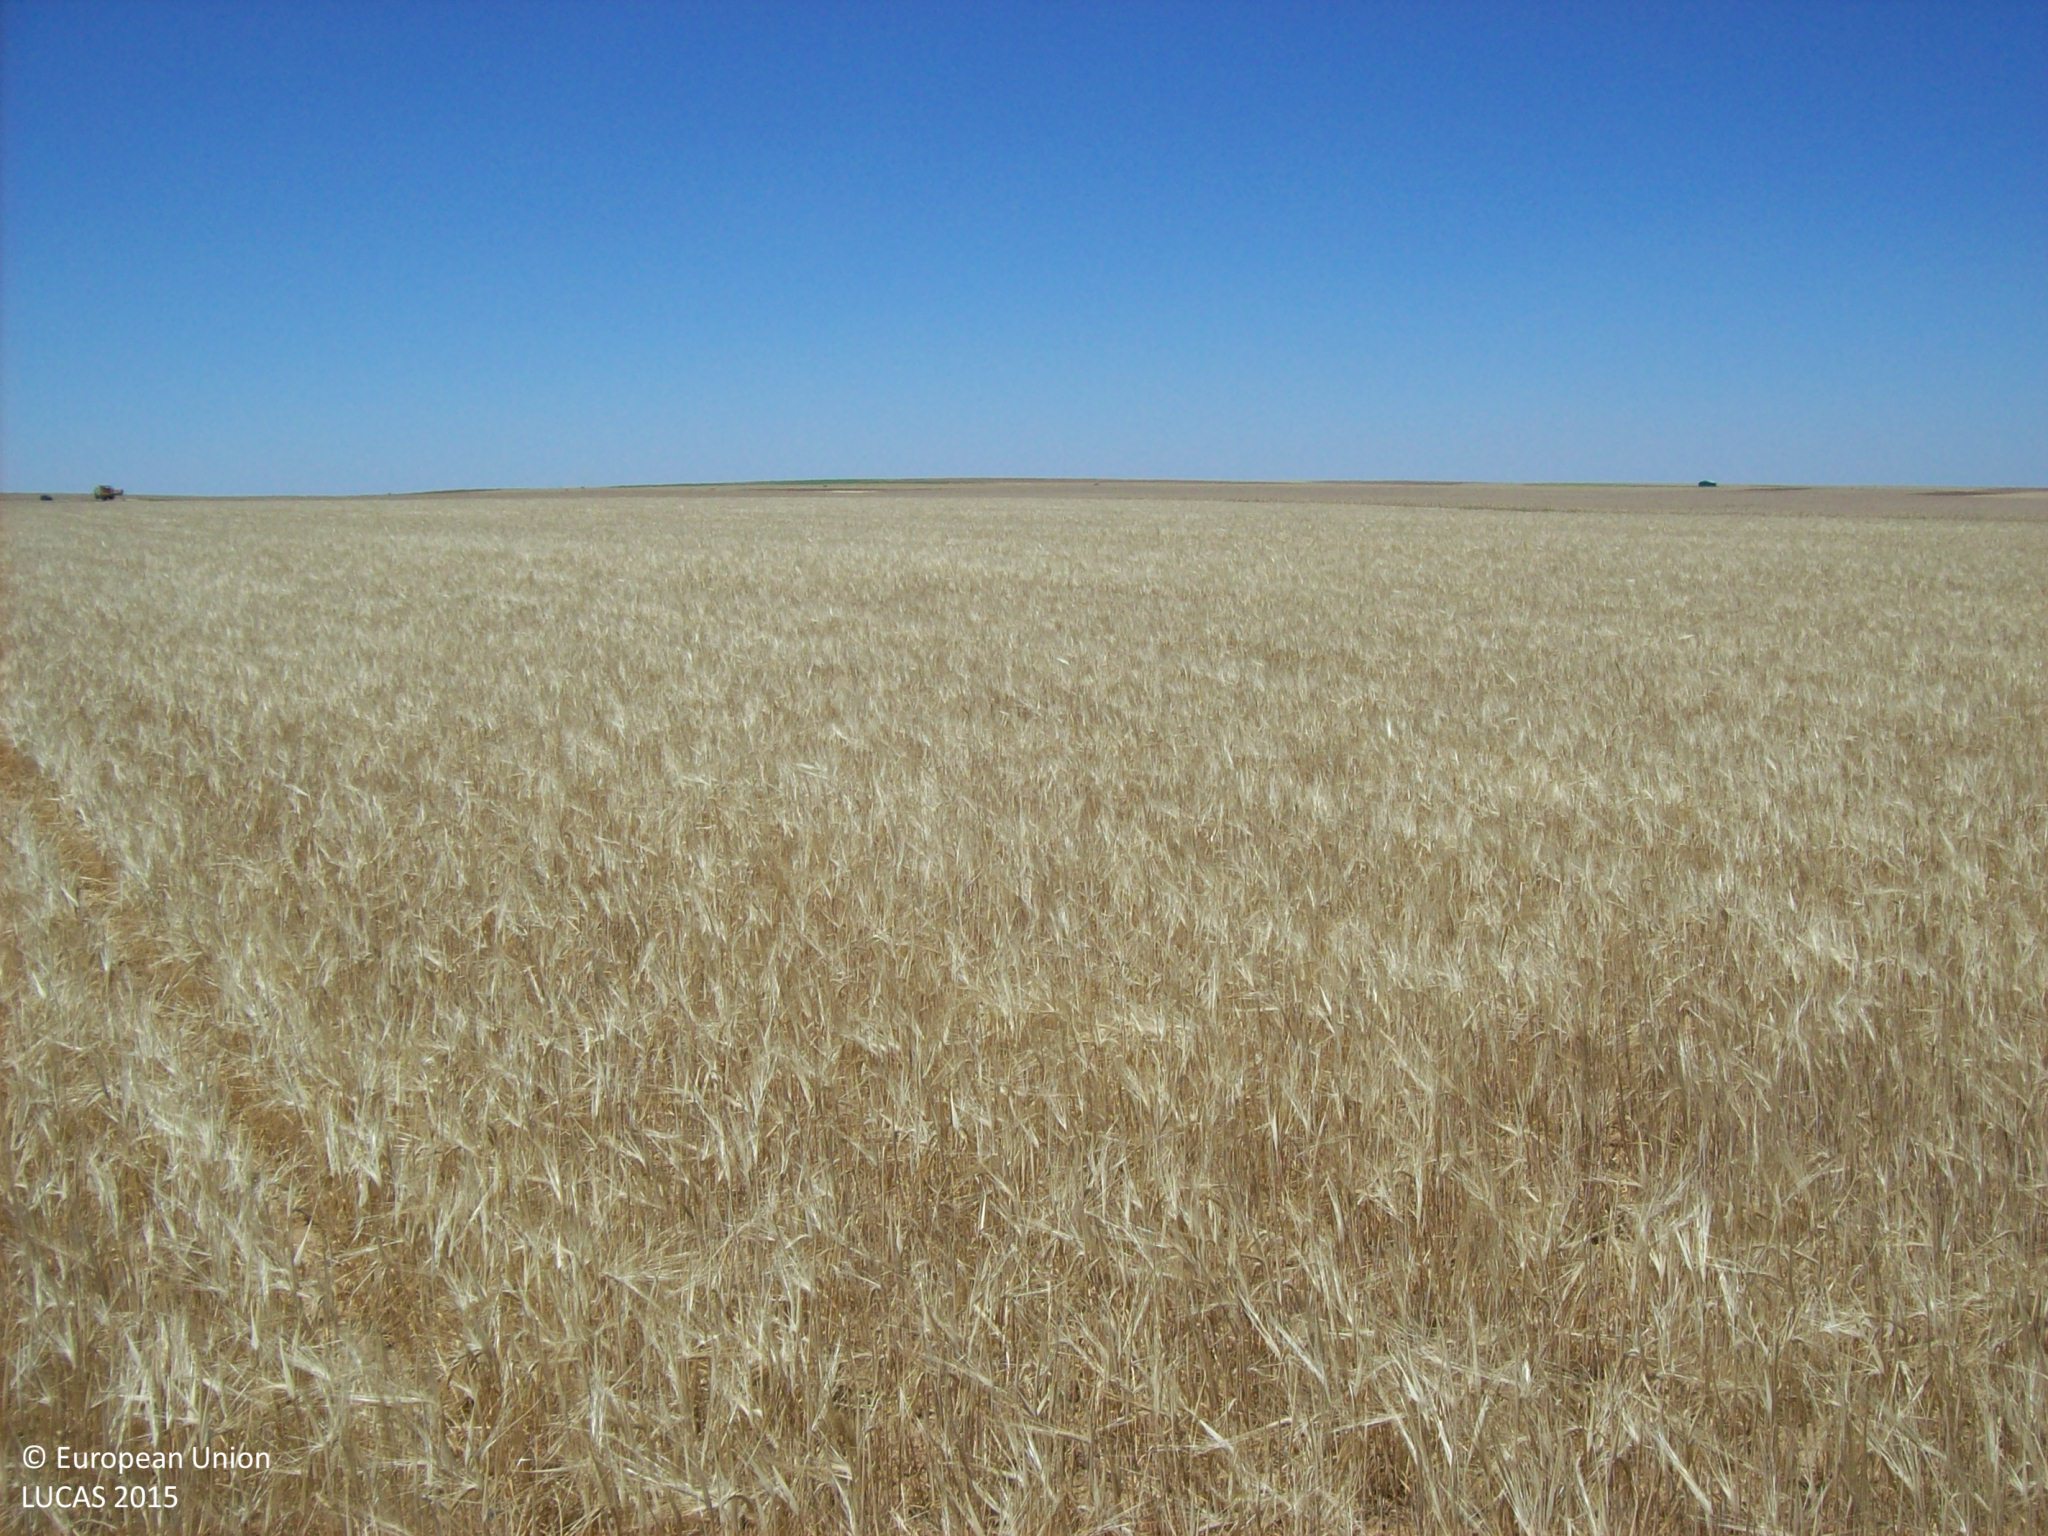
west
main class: Cropland
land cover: Barley
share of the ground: > 75 %
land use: Agriculture (excluding fallow land and kitchen gardens)
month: June
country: ES
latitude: 41.2364
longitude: -5.2375
